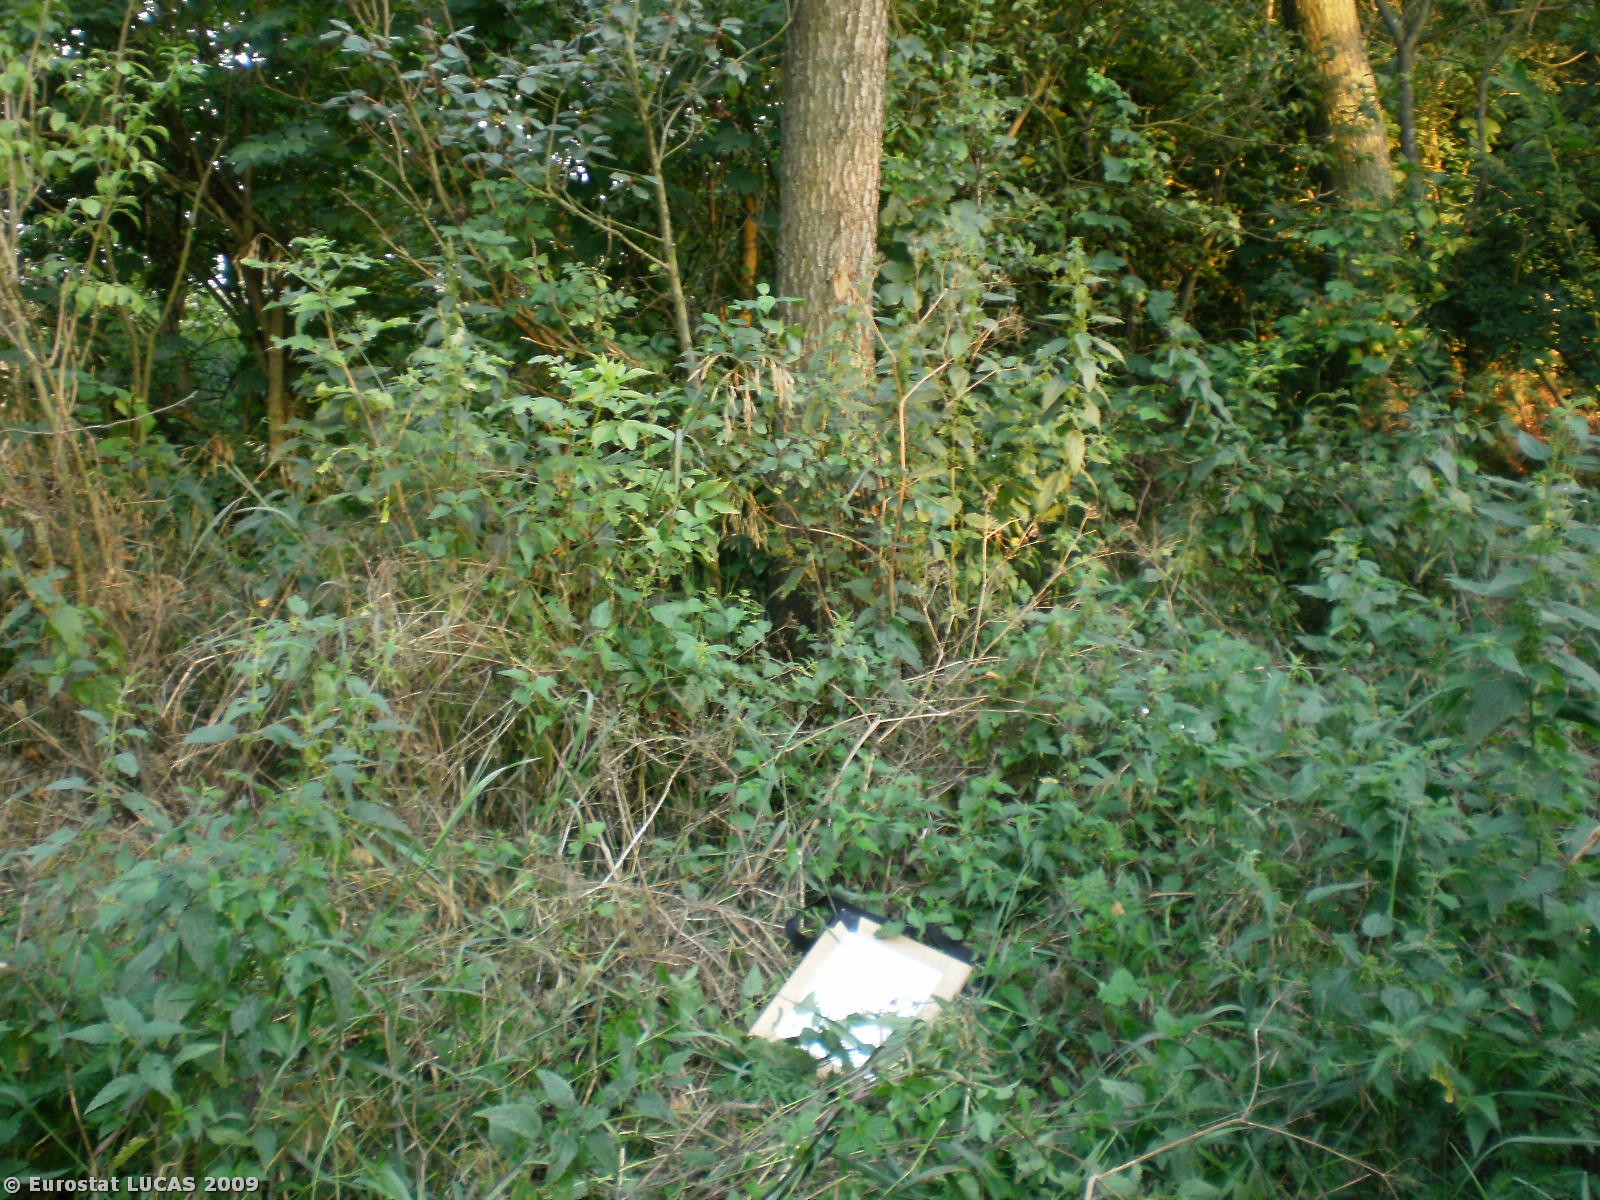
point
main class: Woodland
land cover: Broadleaved woodland
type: mesophytic deciduous forest
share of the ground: 25 - 50 %
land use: Unused
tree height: > 5 m
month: July
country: PL
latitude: 53.4420
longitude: 21.0187
